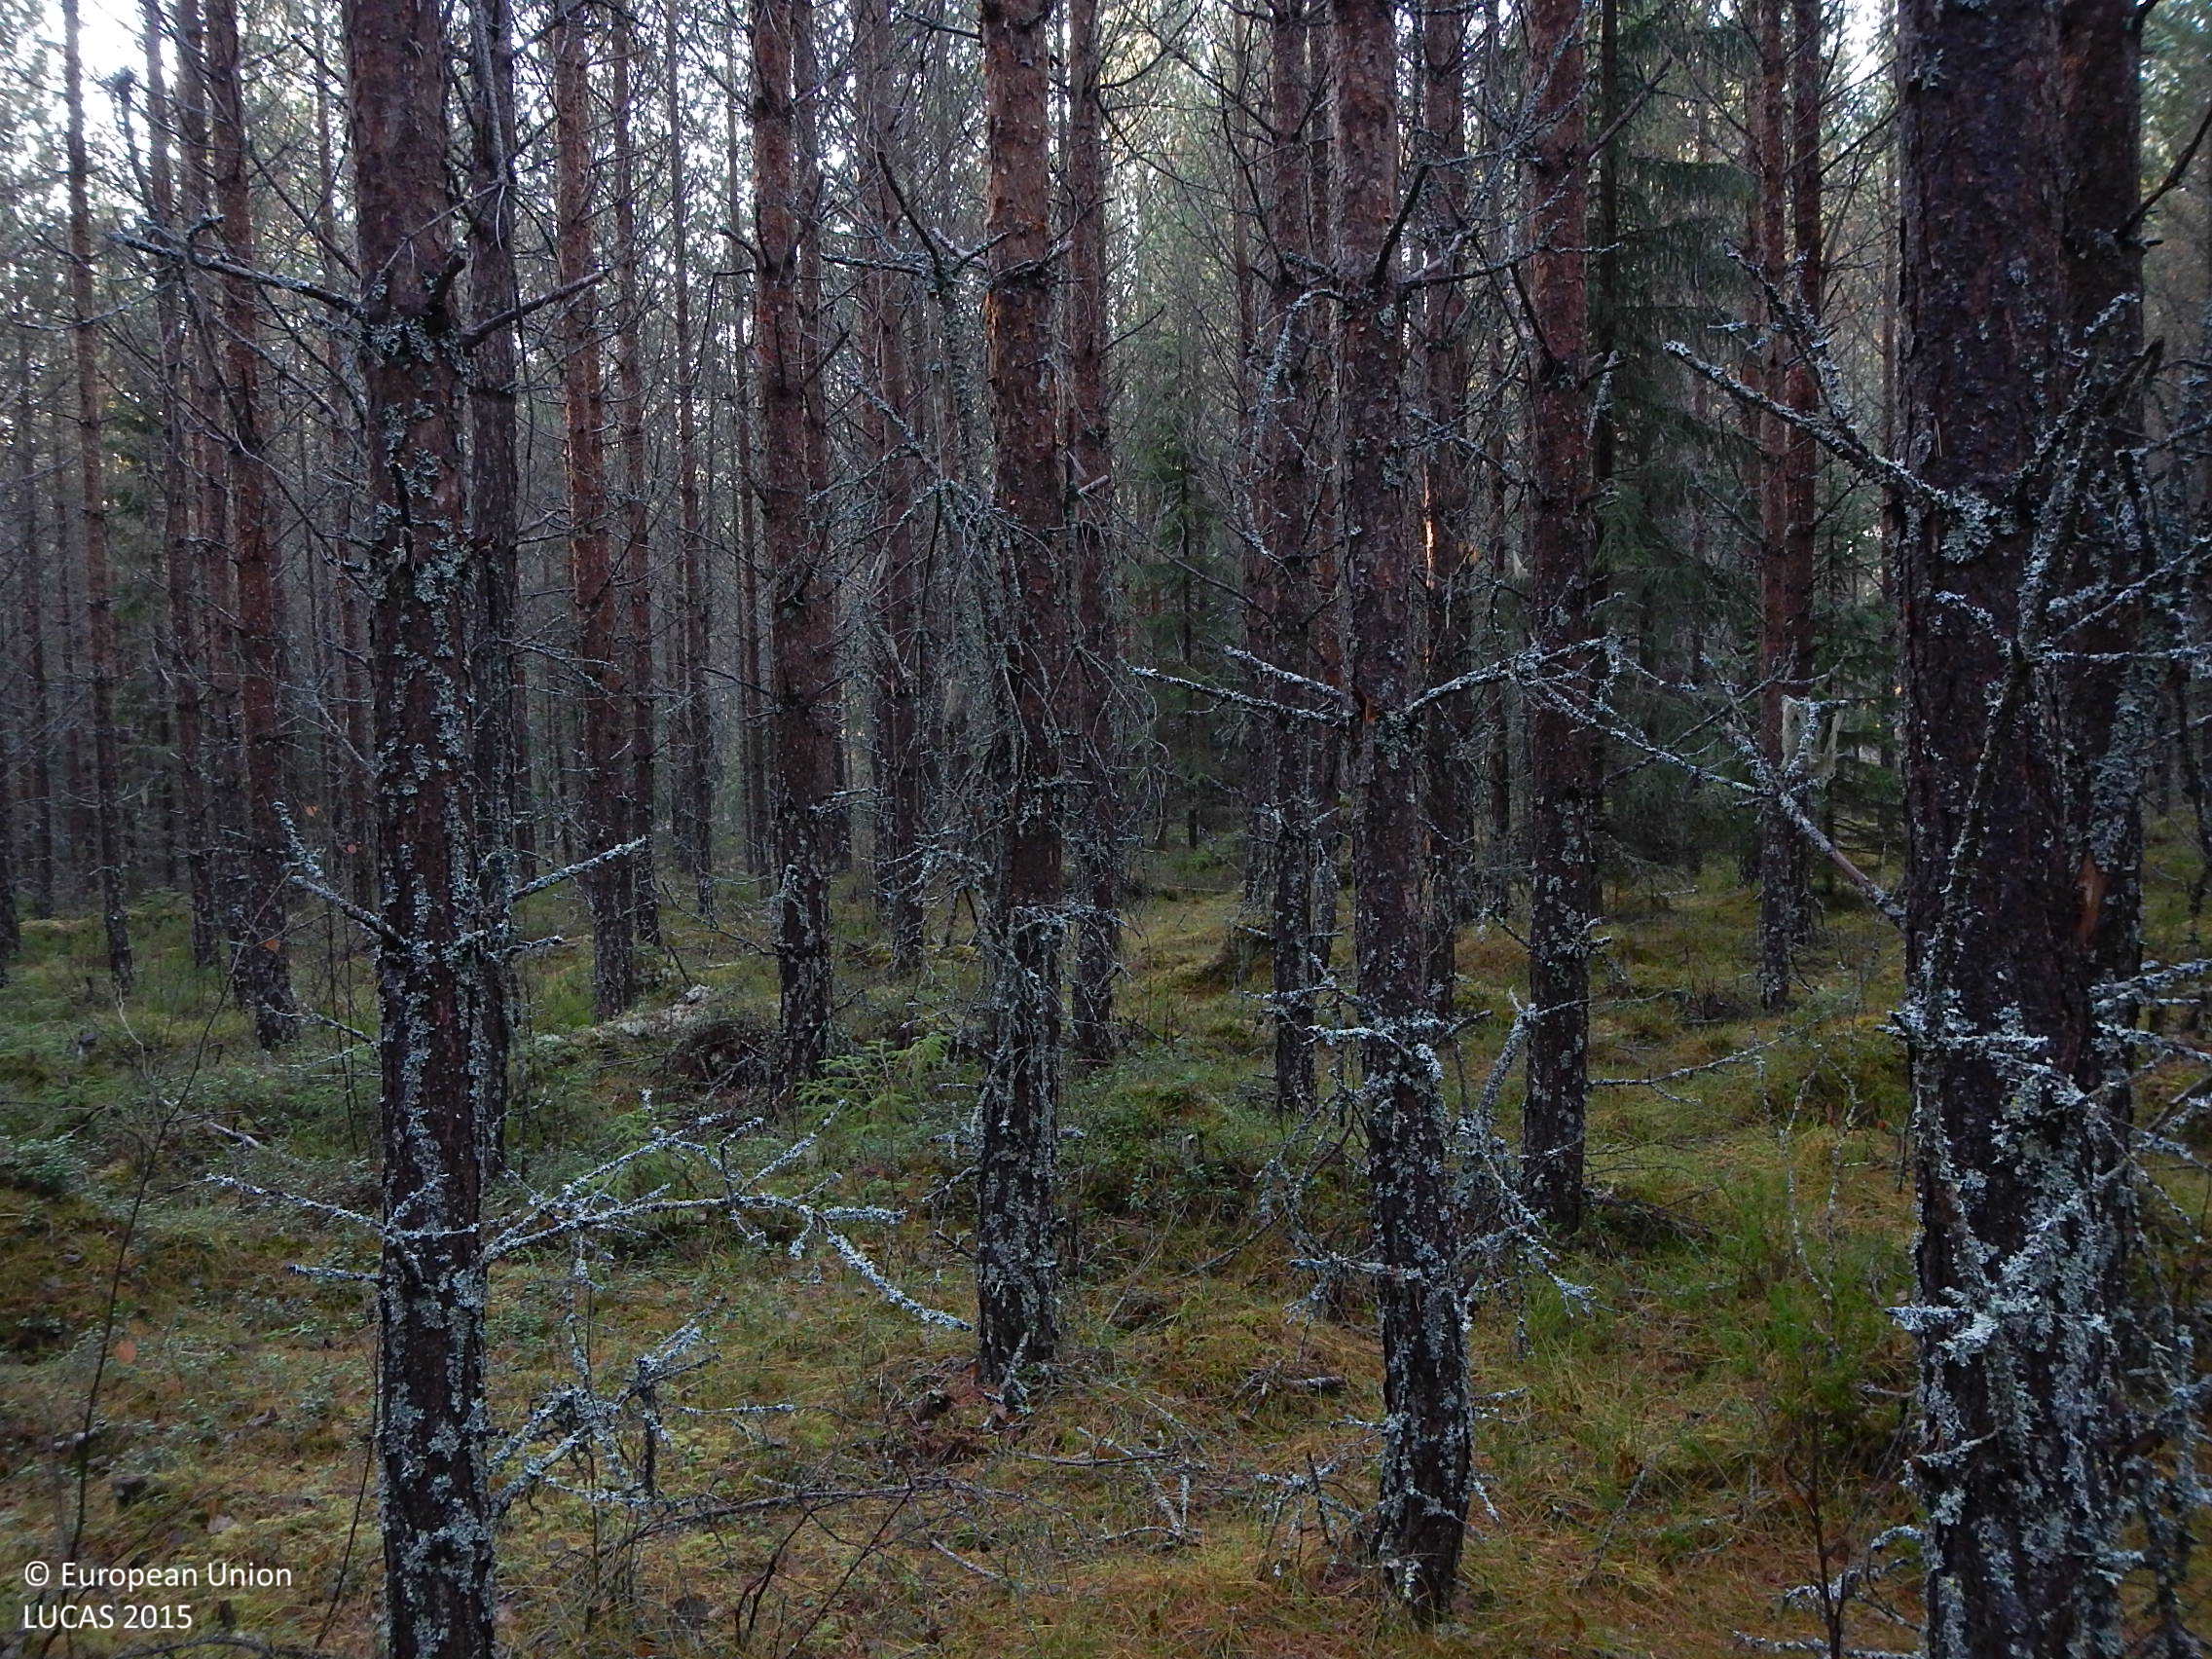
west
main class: Woodland
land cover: Pine dominated coniferous woodland
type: boreal forest
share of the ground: > 75 %
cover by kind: coniferous forest trees 85 %, lichens and mosses 10 %, herbaceous plants 5 %
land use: Forestry
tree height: > 5 m
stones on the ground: < 10 %
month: November
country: SE
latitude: 61.5786
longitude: 15.8033
